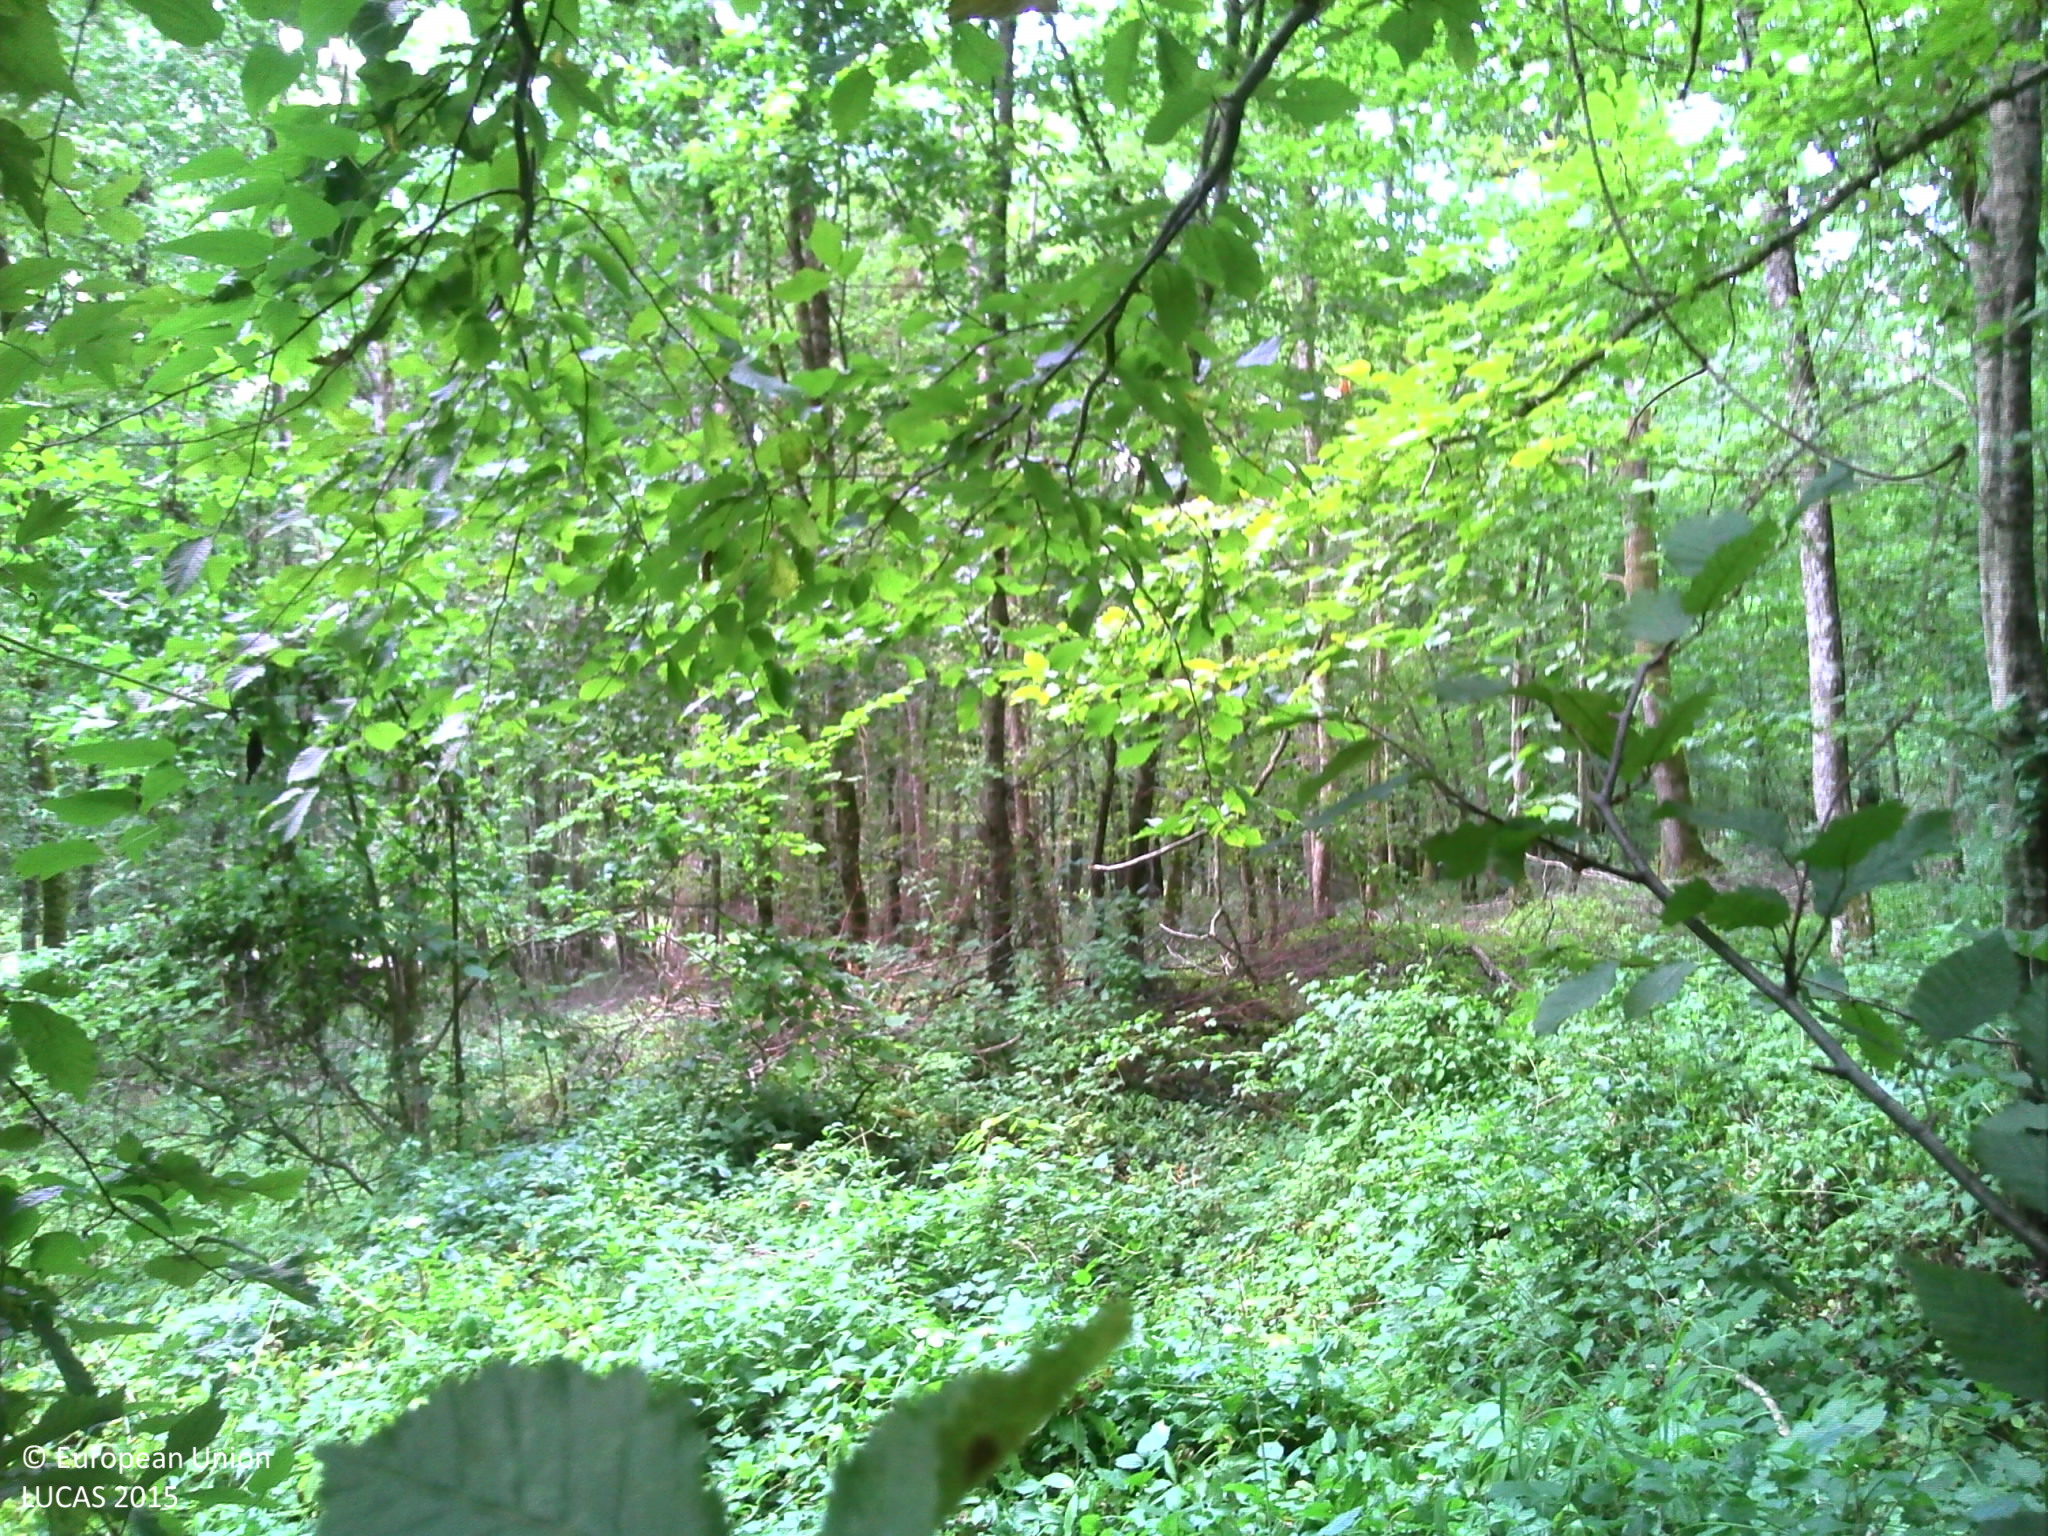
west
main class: Woodland
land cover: Broadleaved woodland
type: mesophytic deciduous forest
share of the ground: > 75 %
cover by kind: broadleaved forest trees 95 %, herbaceous plants 5 %
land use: Forestry
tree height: > 5 m
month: July
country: FR
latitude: 49.1805
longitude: 5.1554
